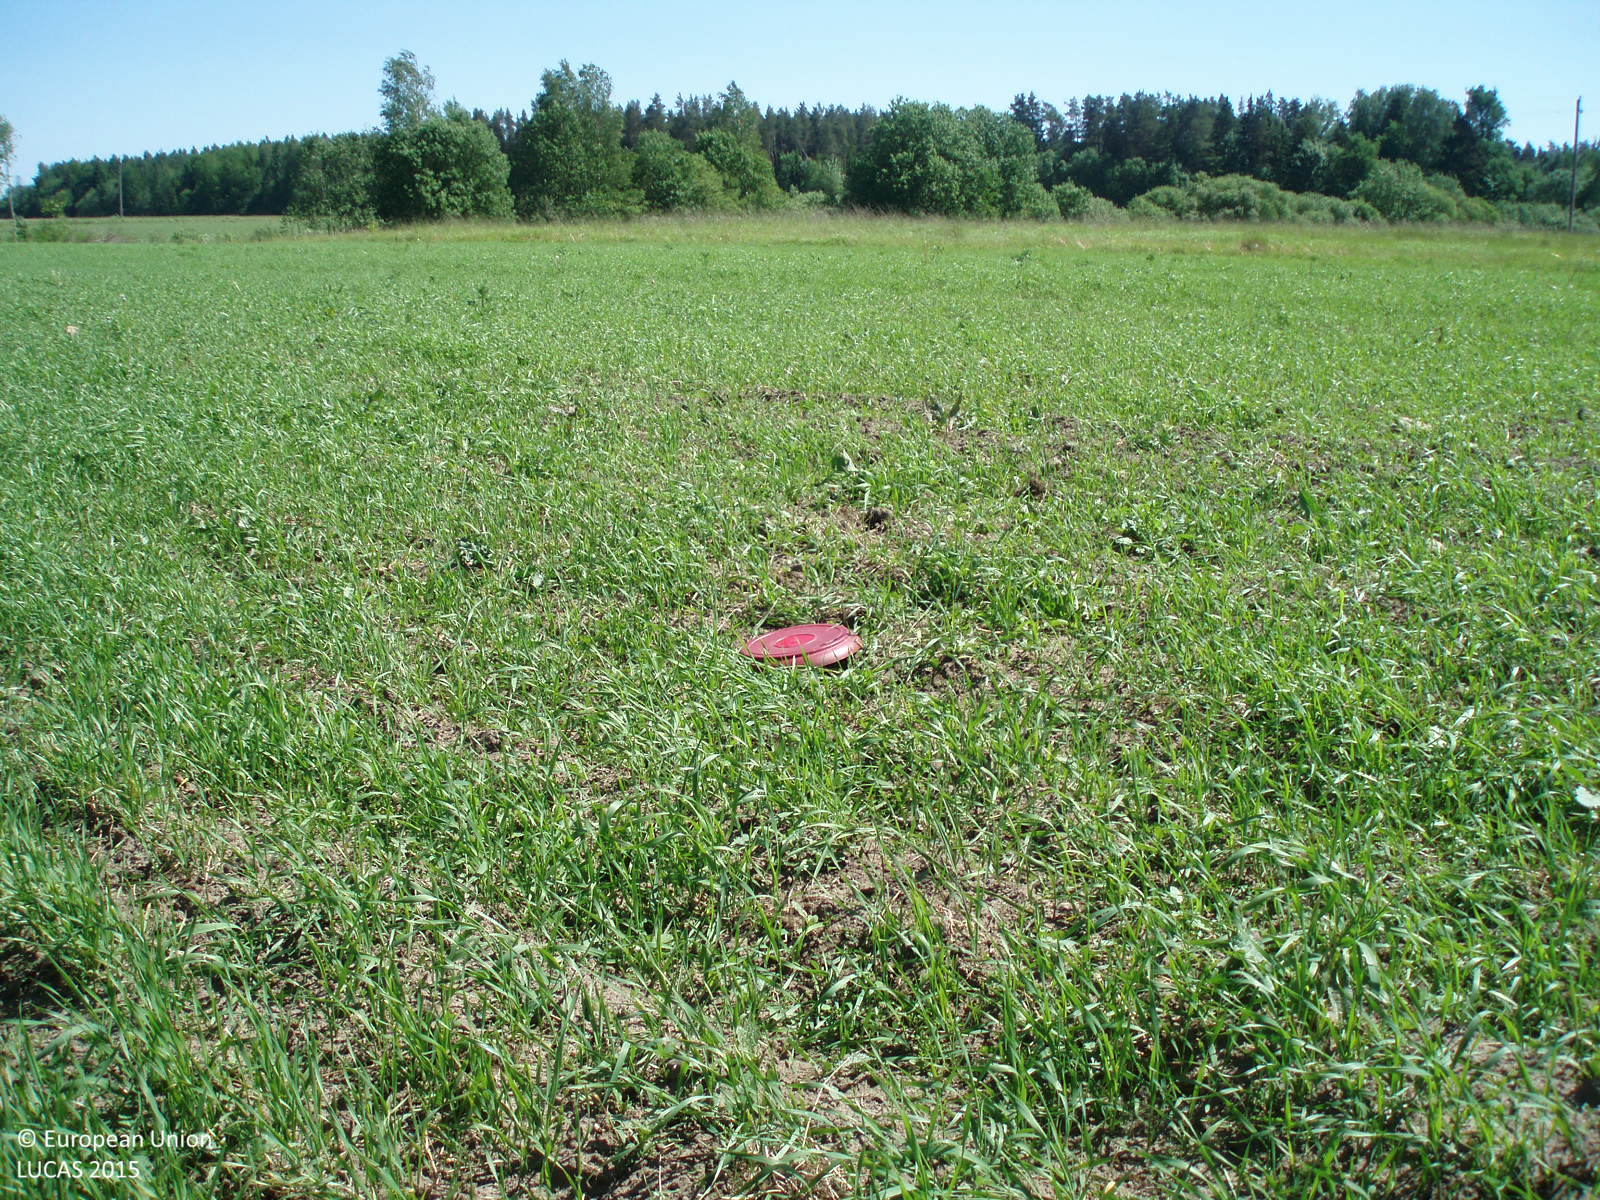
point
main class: Cropland
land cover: Rye
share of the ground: > 75 %
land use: Agriculture (excluding fallow land and kitchen gardens)
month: June
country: LT
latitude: 56.2206
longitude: 22.5904
